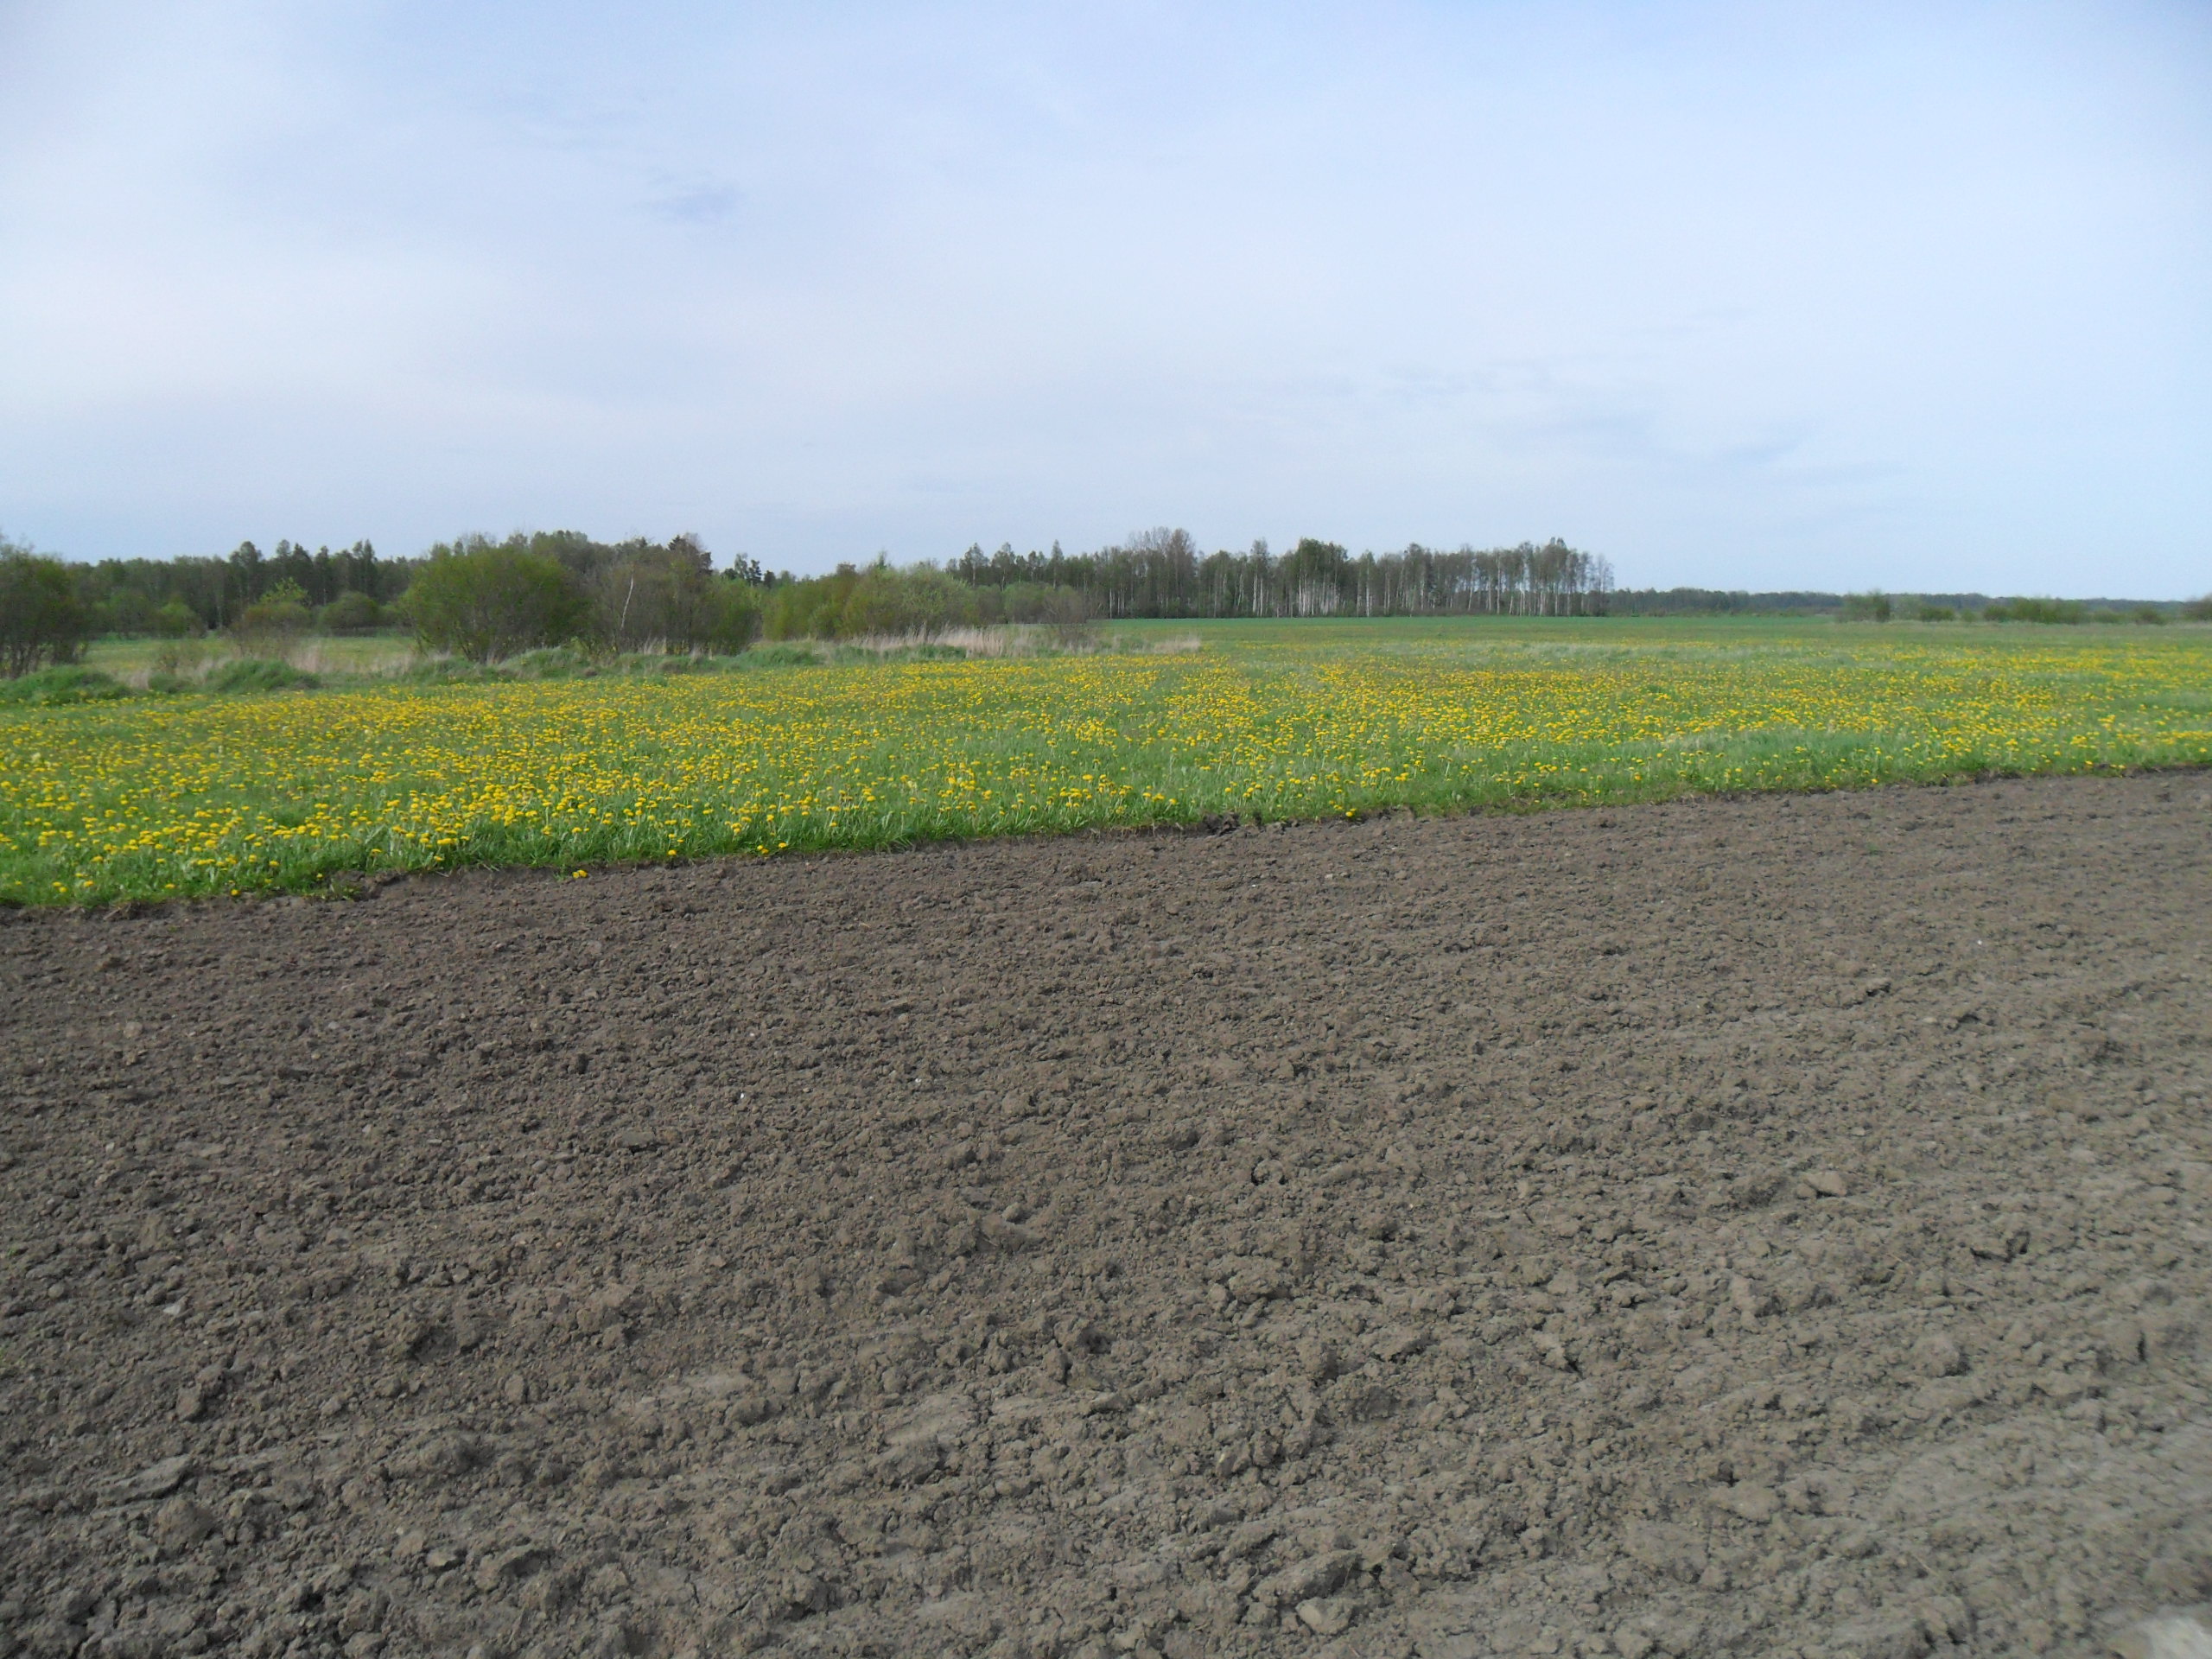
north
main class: Cropland
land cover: Rape and turnip rape
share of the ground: < 10 %
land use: Agriculture (excluding fallow land and kitchen gardens)
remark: Tilled/Sowed
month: May
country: LV
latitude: 57.2728
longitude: 23.0149
